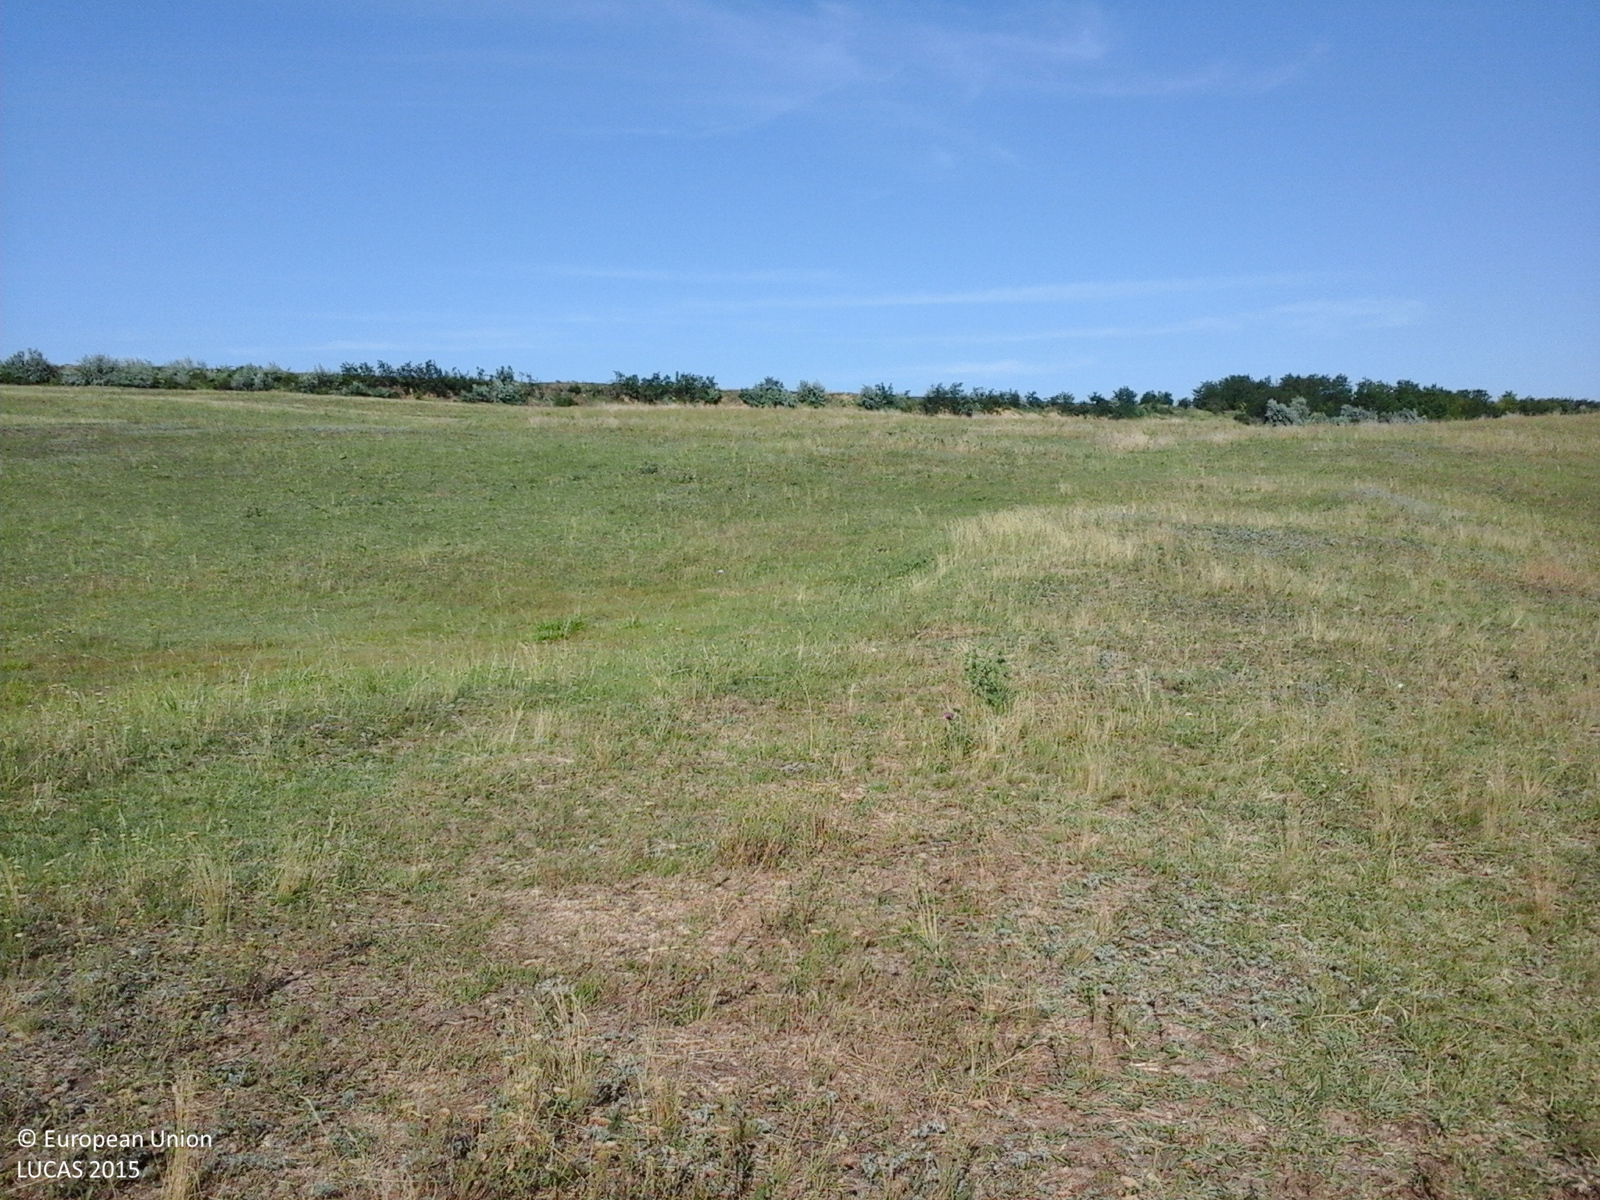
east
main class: Grassland
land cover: Grassland without tree/shrub cover
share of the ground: > 75 %
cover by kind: herbaceous plants 100 %
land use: Agriculture (excluding fallow land and kitchen gardens)
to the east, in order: Grassland without tree/shrub cover; Tracks; Grassland without tree/shrub cover
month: June
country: RO
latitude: 47.4976
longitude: 27.1112
